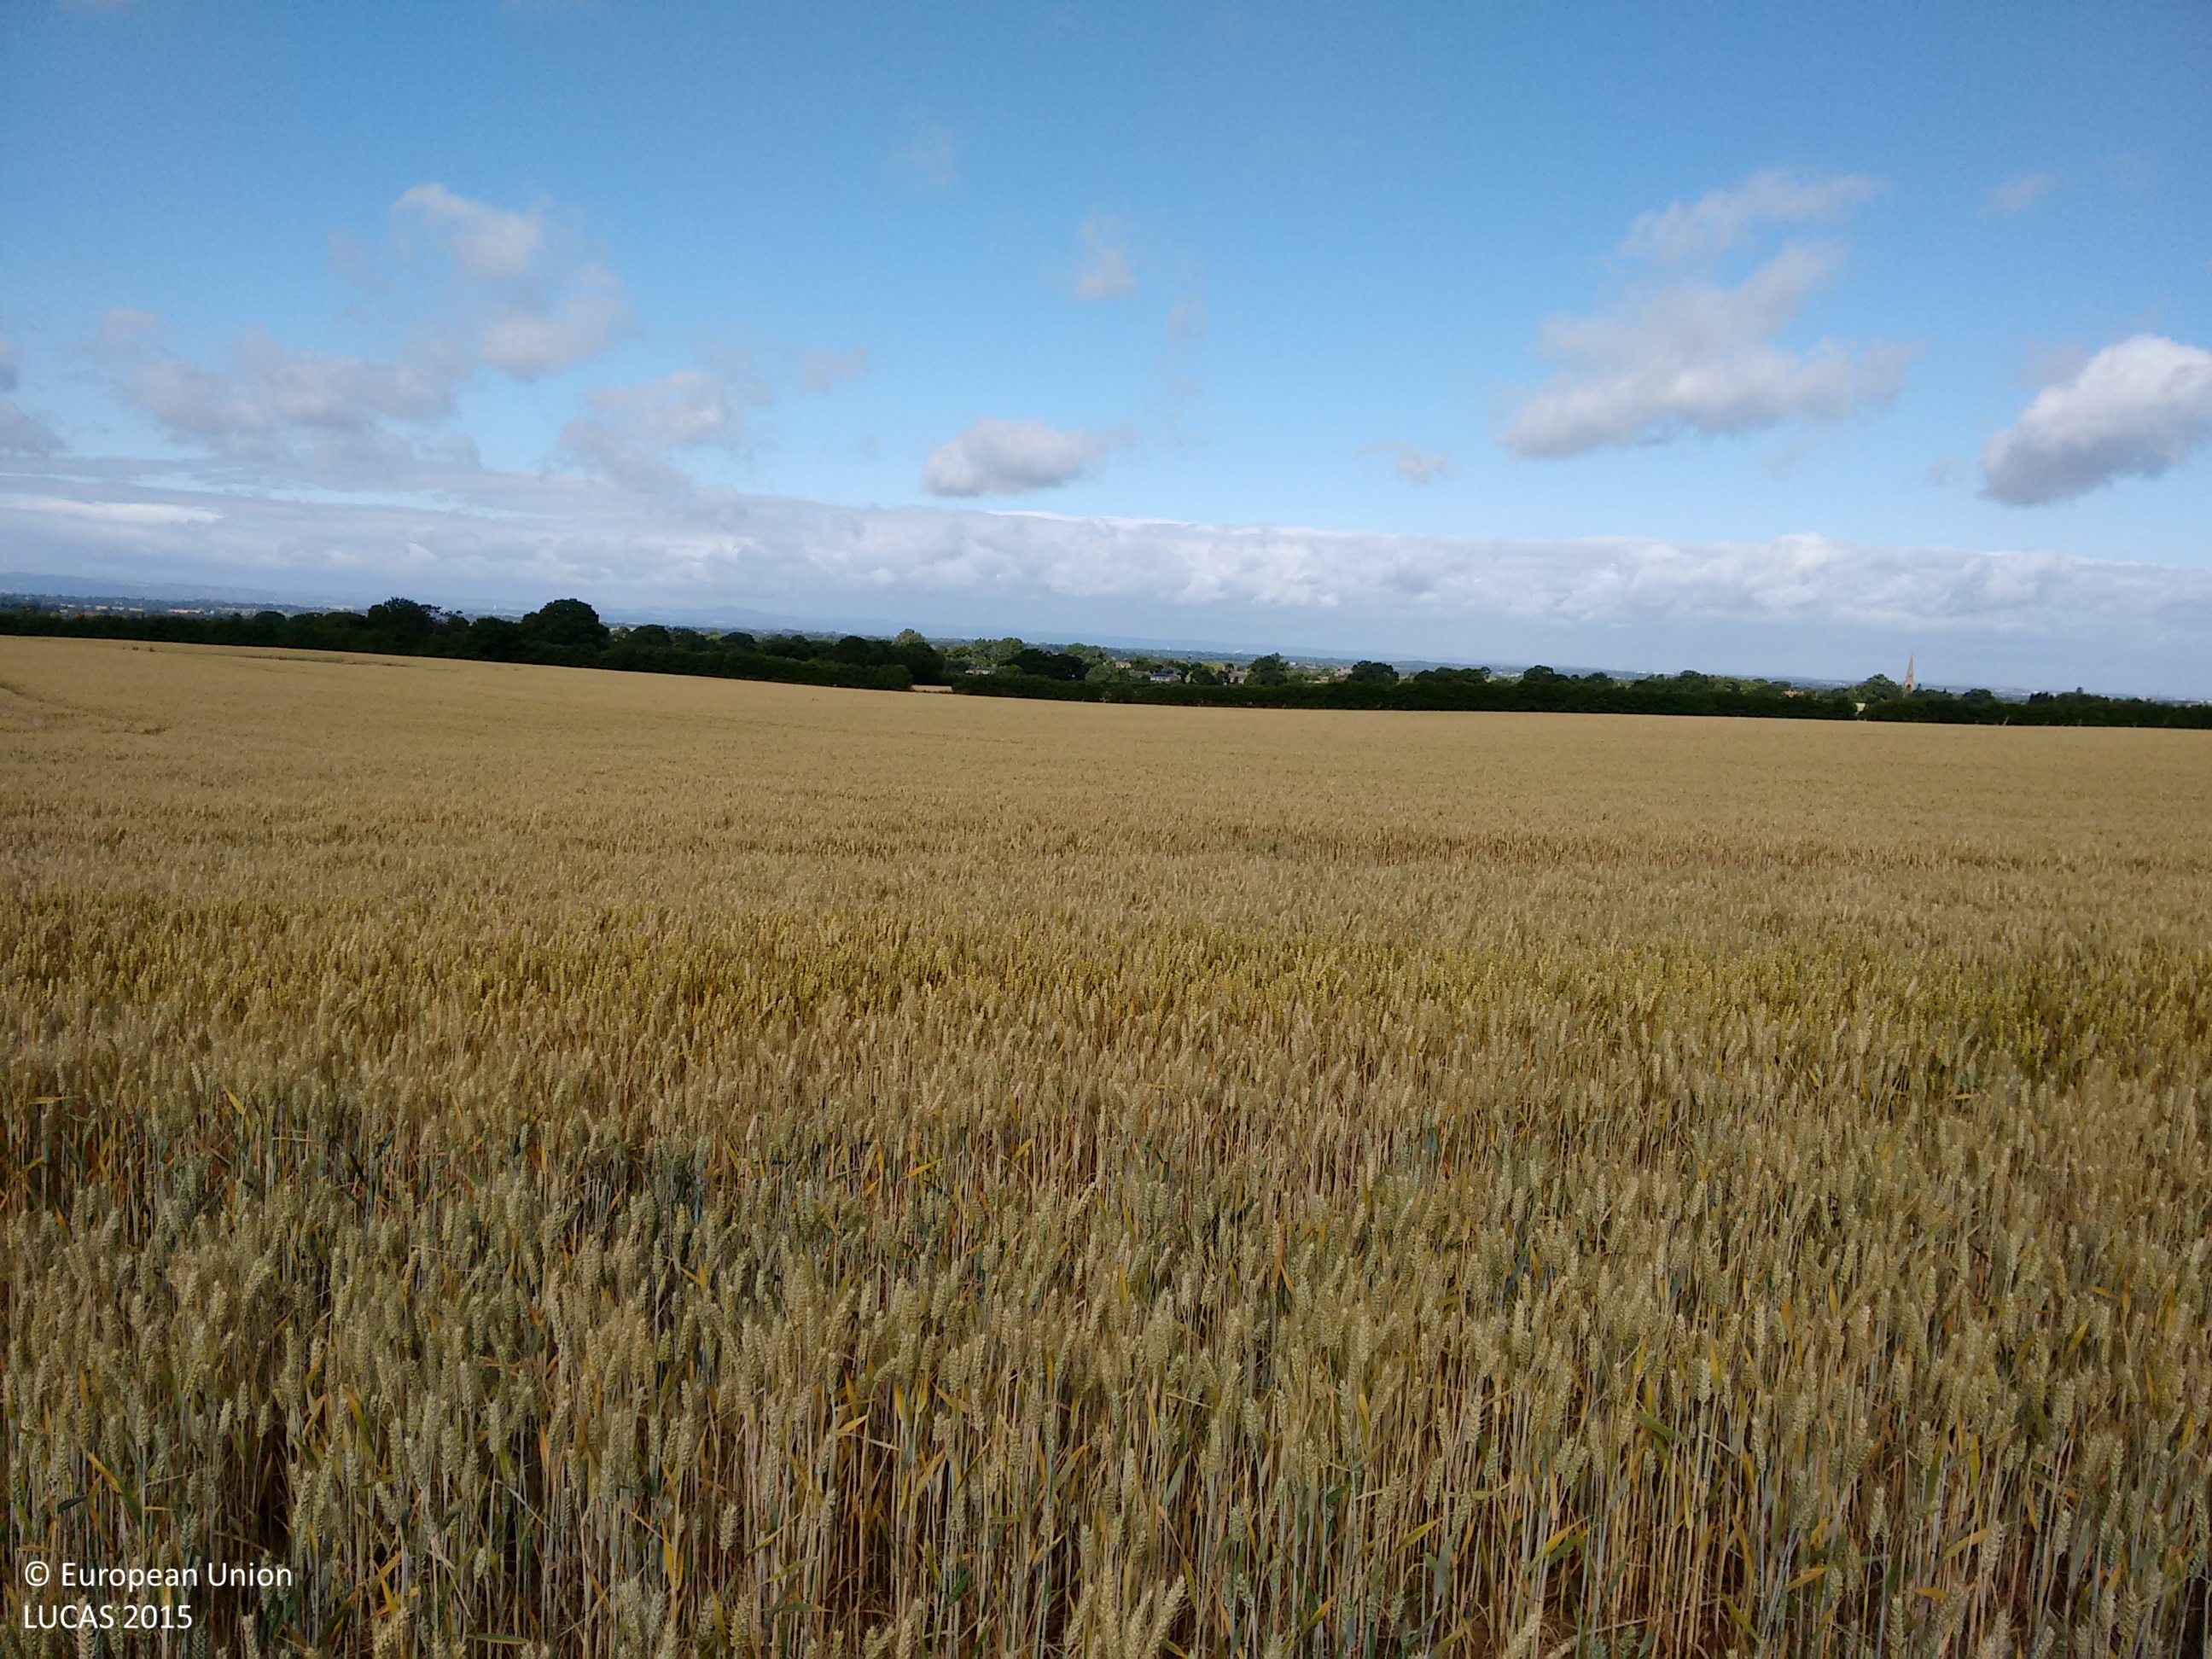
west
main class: Cropland
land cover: Common wheat
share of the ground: > 75 %
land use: Agriculture (excluding fallow land and kitchen gardens)
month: July
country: GB
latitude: 53.2189
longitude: -2.7247
